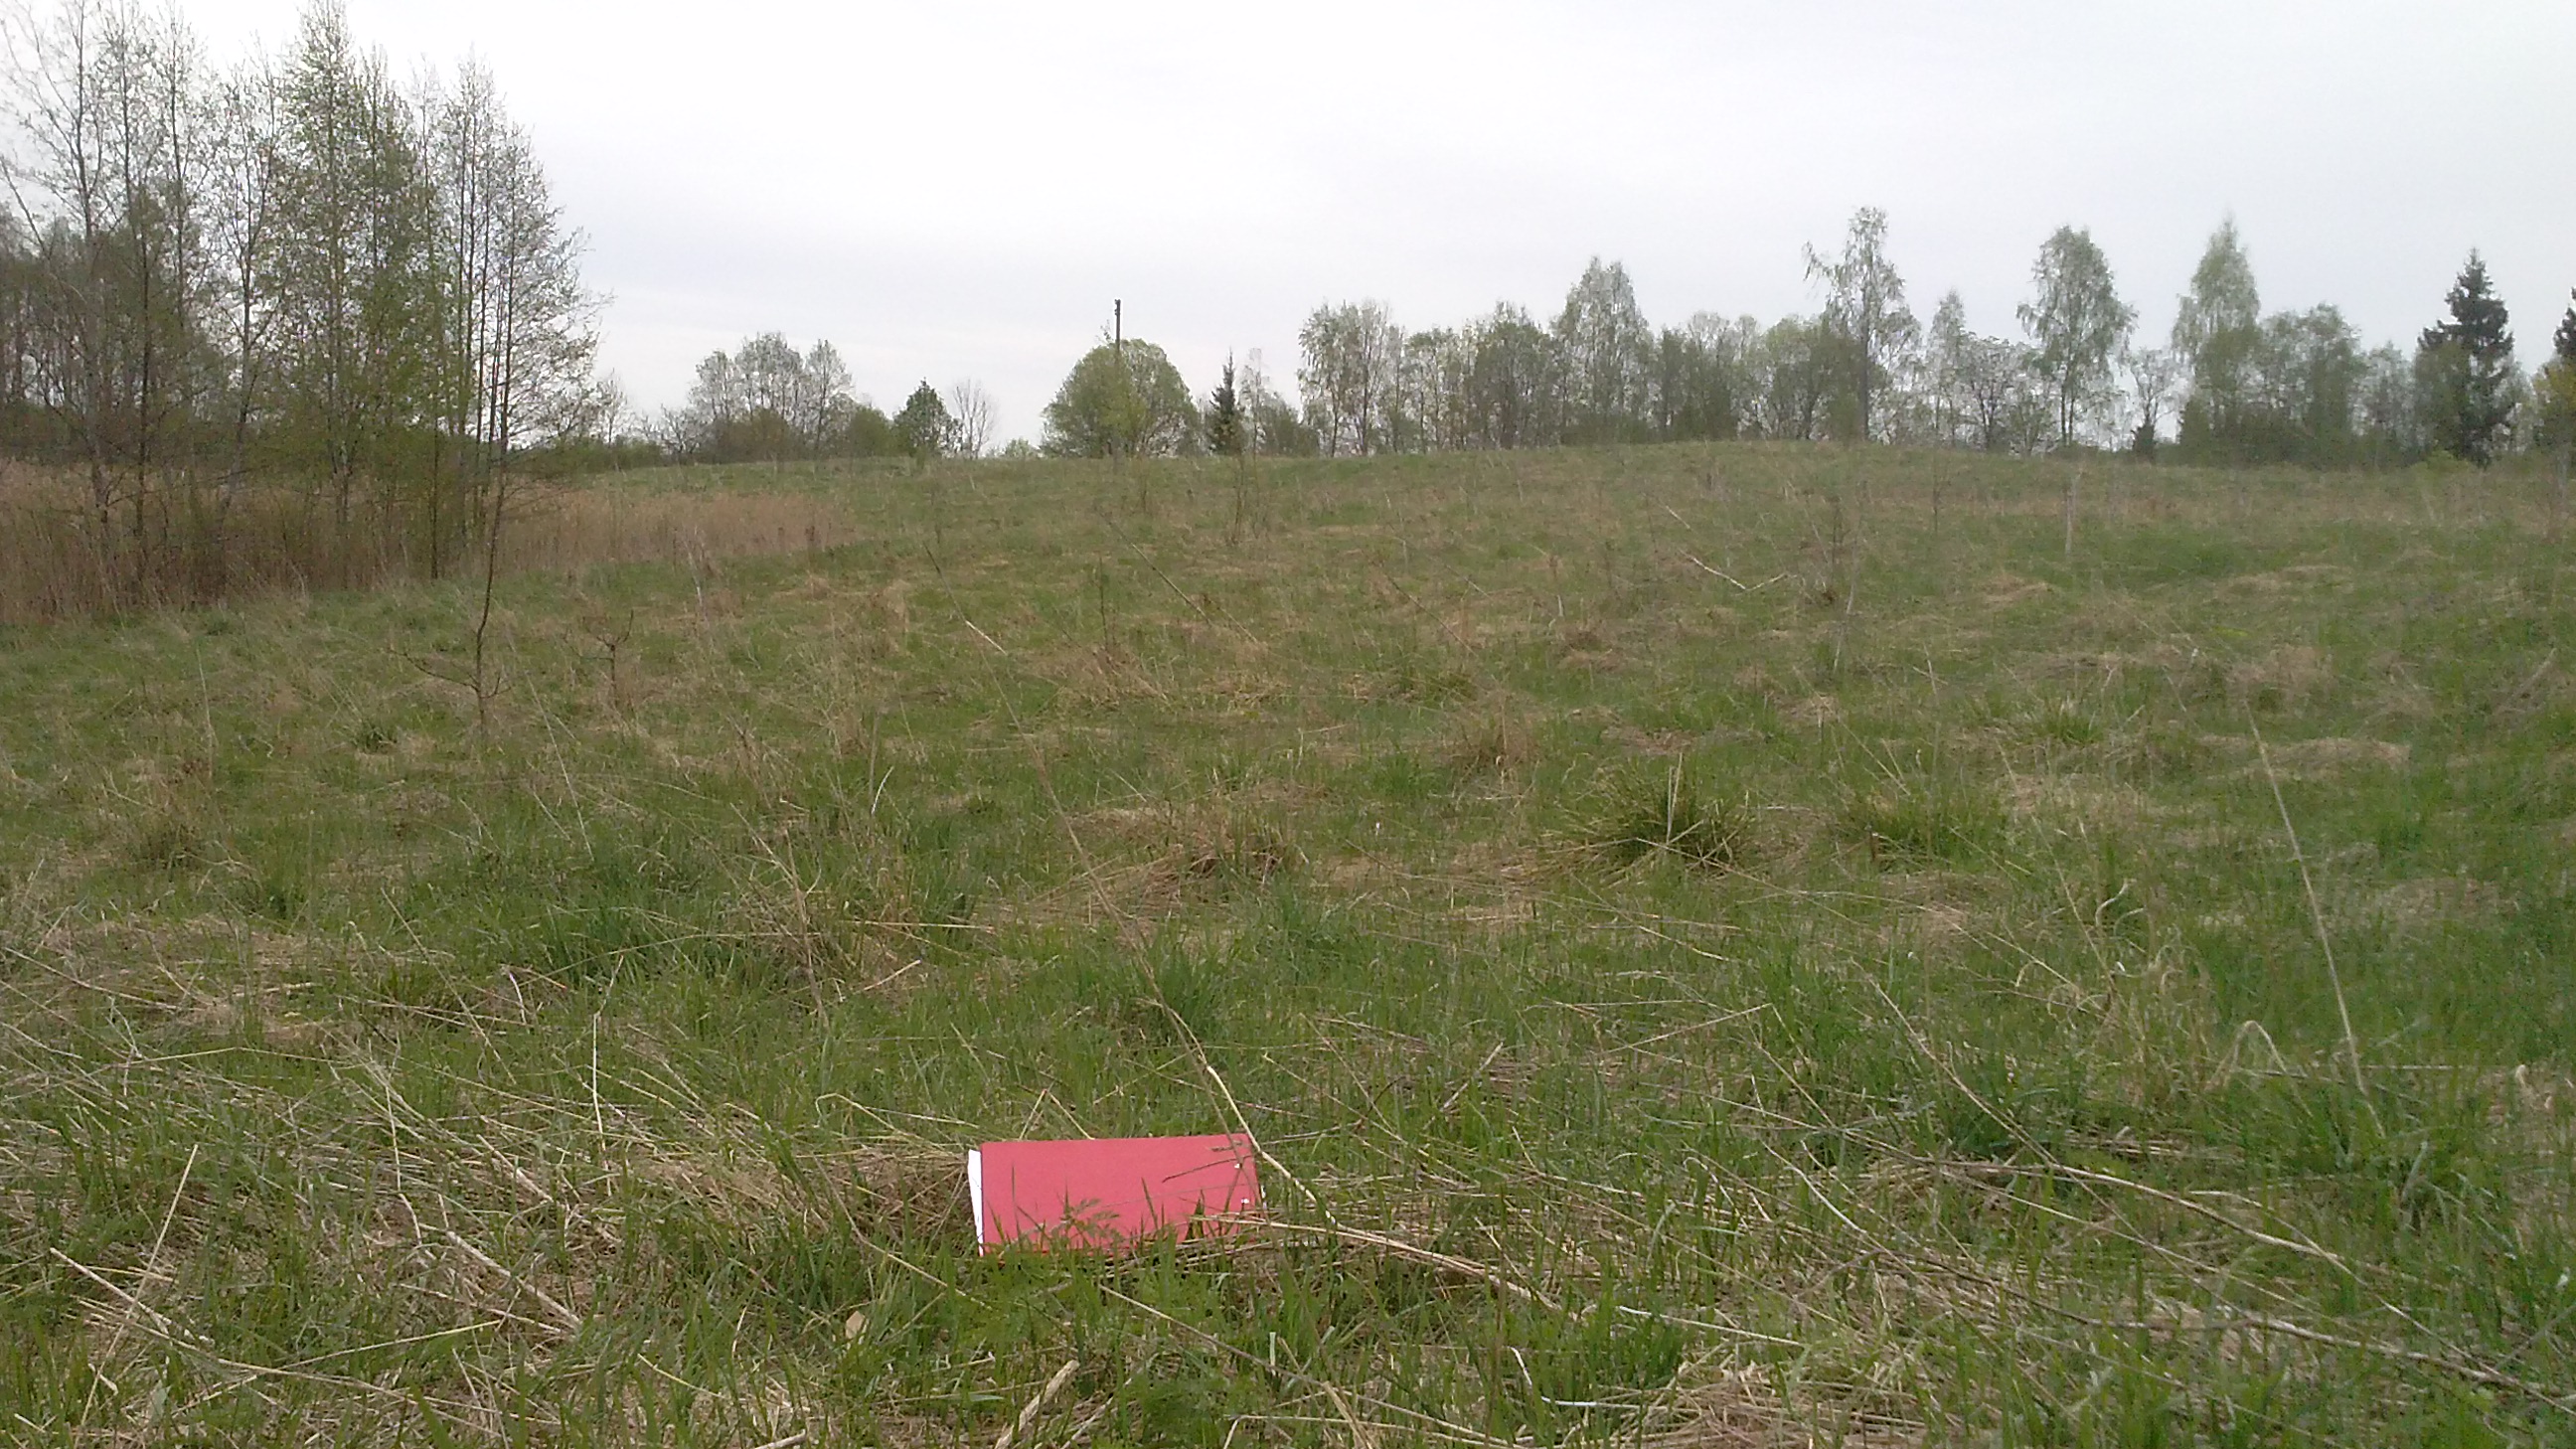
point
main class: Grassland
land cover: Grassland without tree/shrub cover
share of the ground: > 75 %
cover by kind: herbaceous plants 100 %
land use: Agriculture (excluding fallow land and kitchen gardens)
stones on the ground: < 10 %
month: May
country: LV
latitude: 55.9710
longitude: 27.2042
